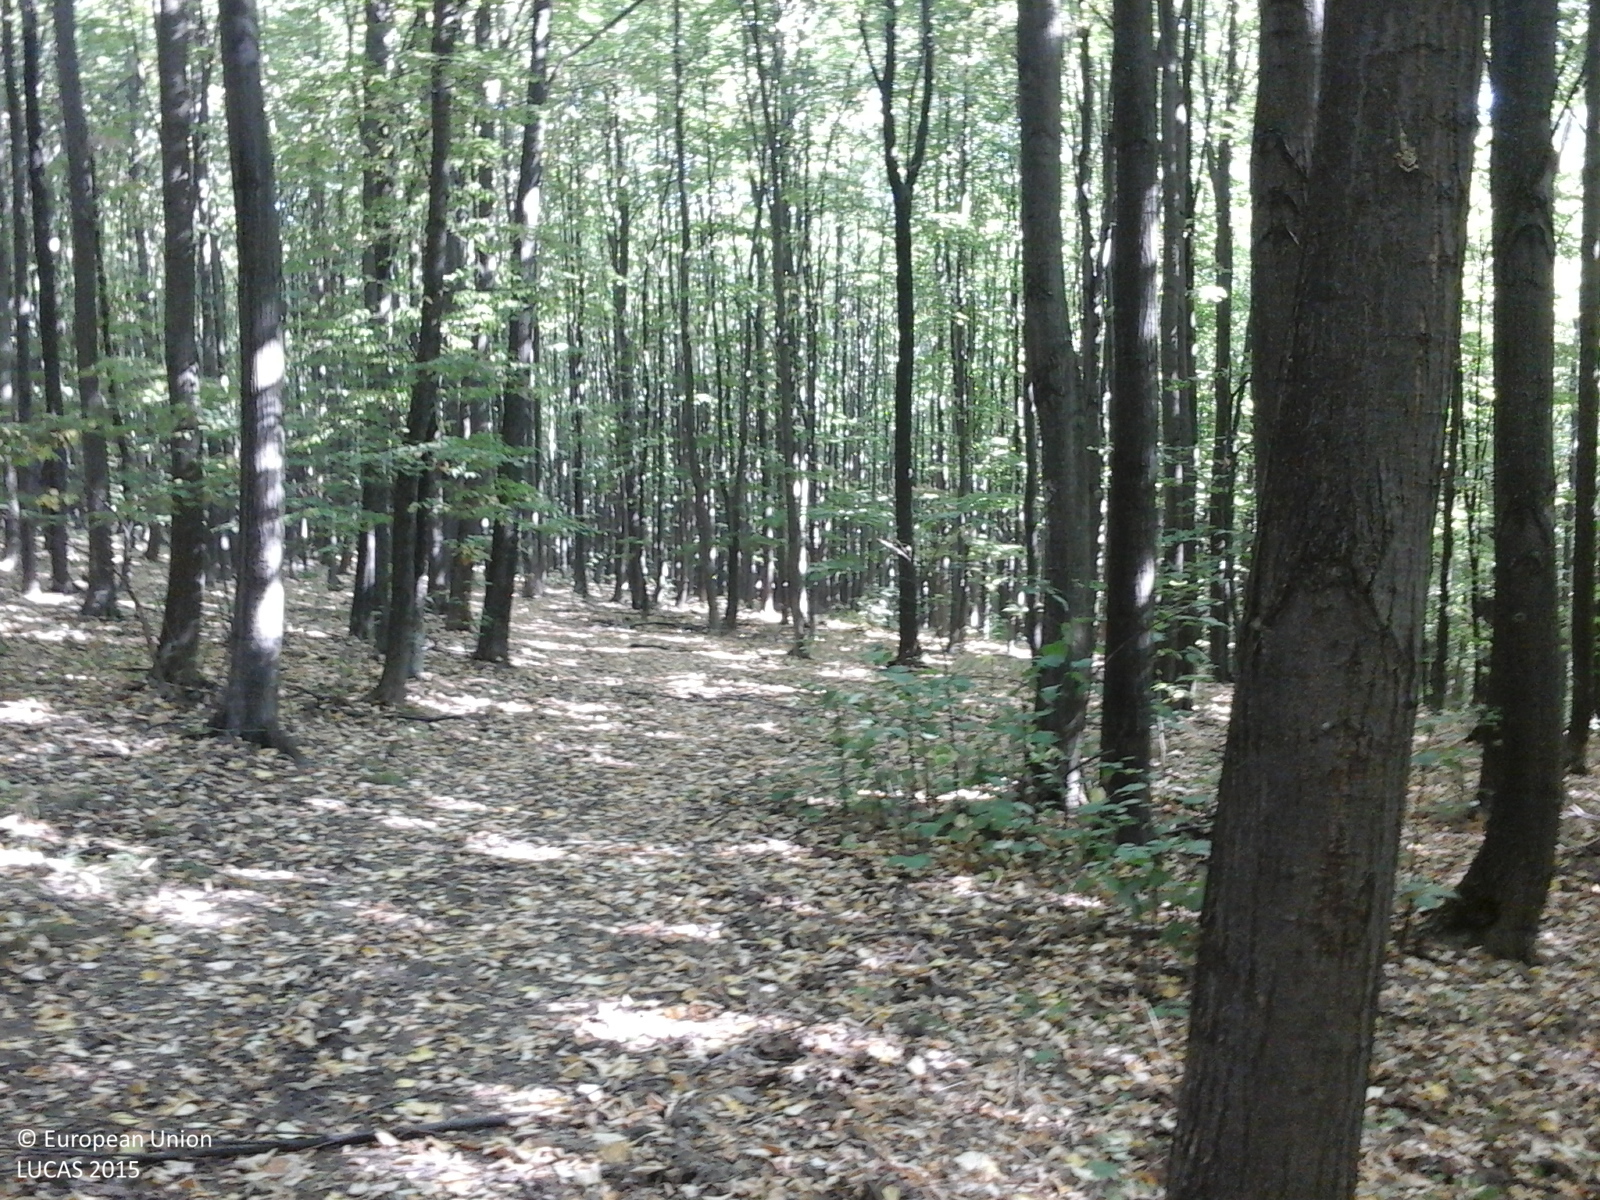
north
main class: Woodland
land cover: Broadleaved woodland
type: thermophilous deciduous forest
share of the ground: > 75 %
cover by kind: broadleaved forest trees 100 %
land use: Forestry
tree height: > 5 m
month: July
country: RO
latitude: 46.4505
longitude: 27.3286
